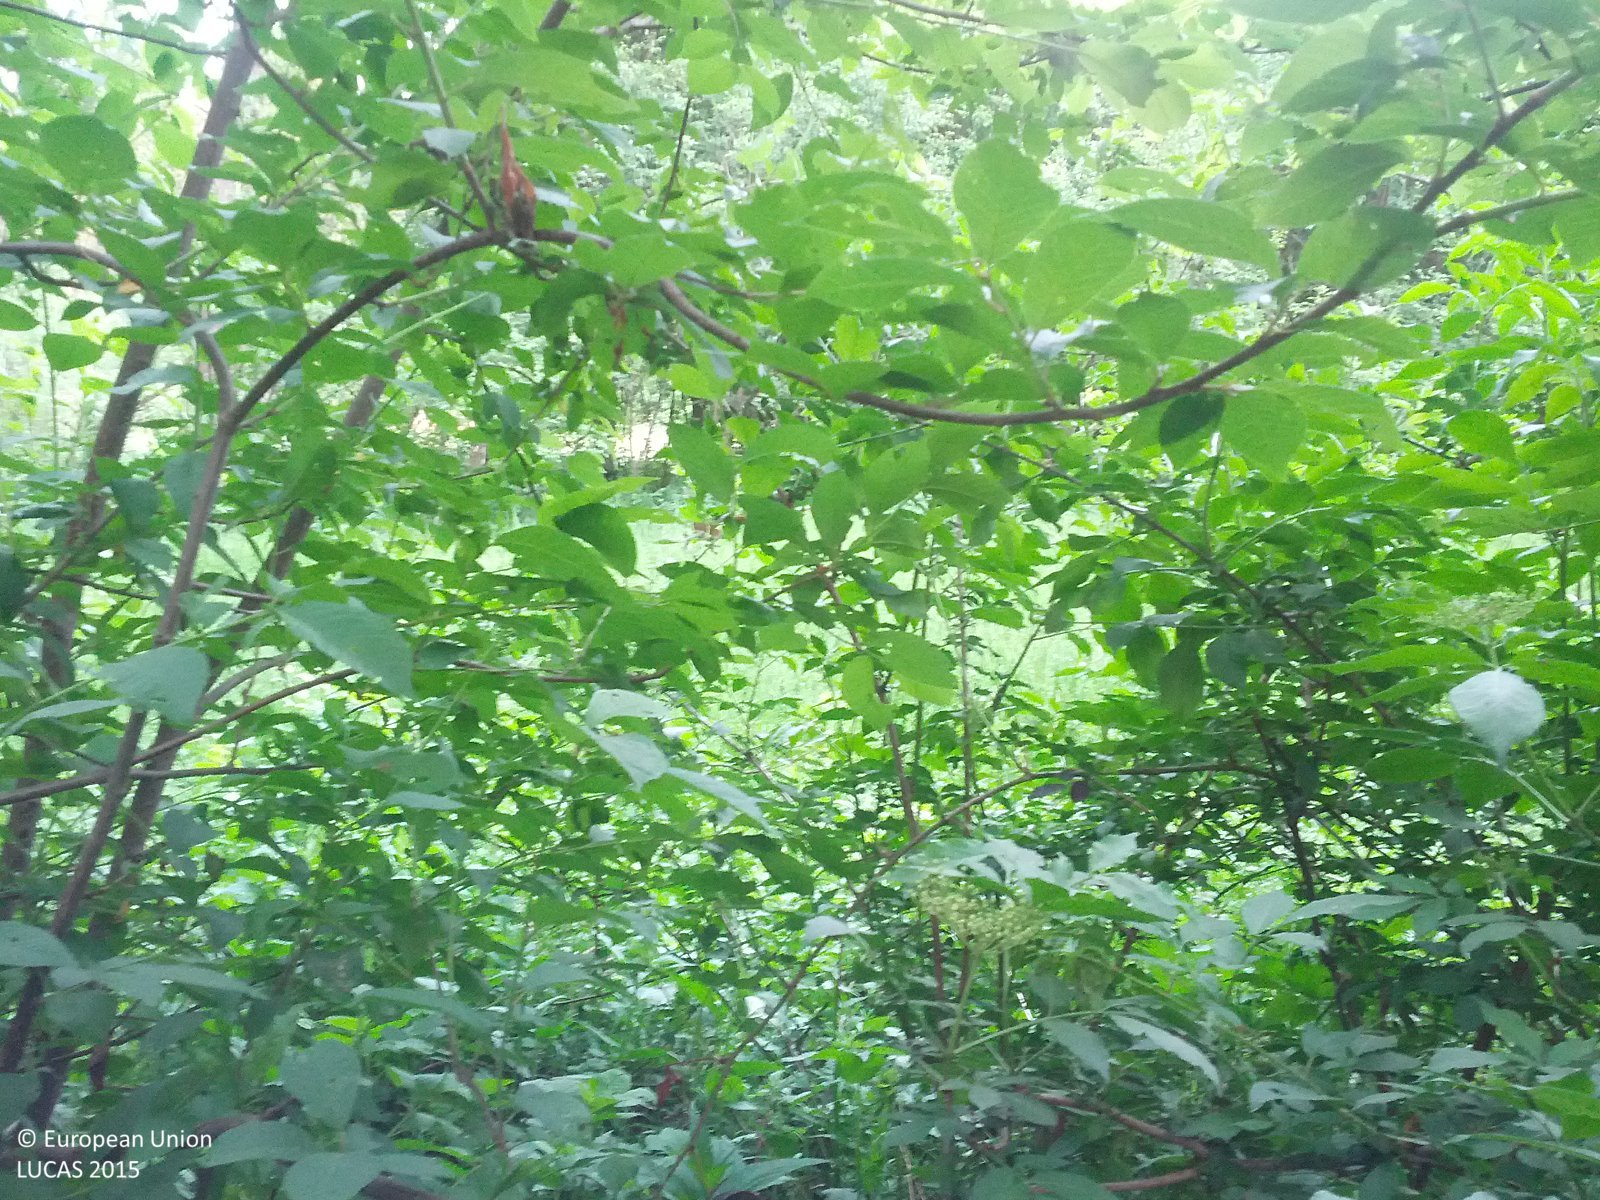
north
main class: Woodland
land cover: Broadleaved woodland
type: floodplain forest
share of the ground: > 75 %
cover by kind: broadleaved forest trees 40 %, shrubs 40 %, herbaceous plants 20 %
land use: Semi-natural and natural areas not in use
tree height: > 5 m
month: May
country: AT
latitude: 47.3325
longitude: 16.1027
